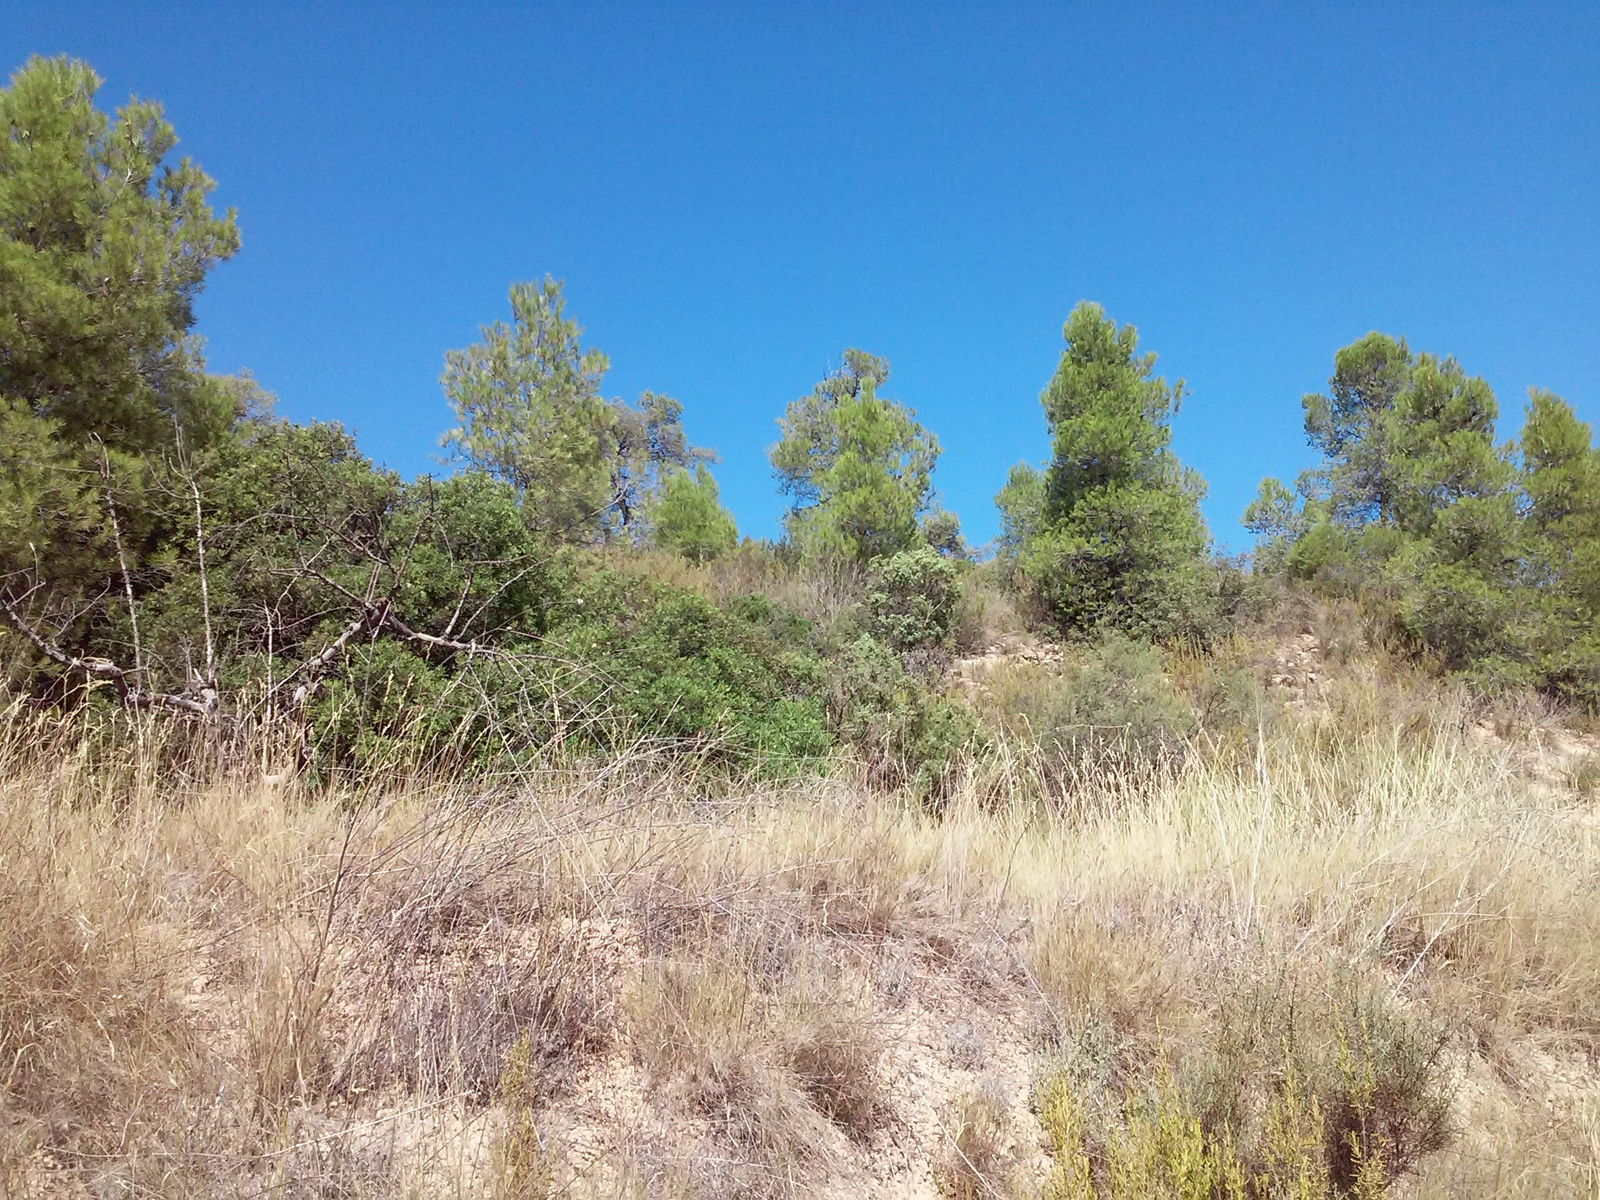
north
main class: Cropland
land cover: Nuts trees
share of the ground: 10 - 25 %
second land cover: Grassland without tree/shrub cover
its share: > 75 %
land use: Abandoned areas
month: September
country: ES
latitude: 41.2165
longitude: 0.6038
